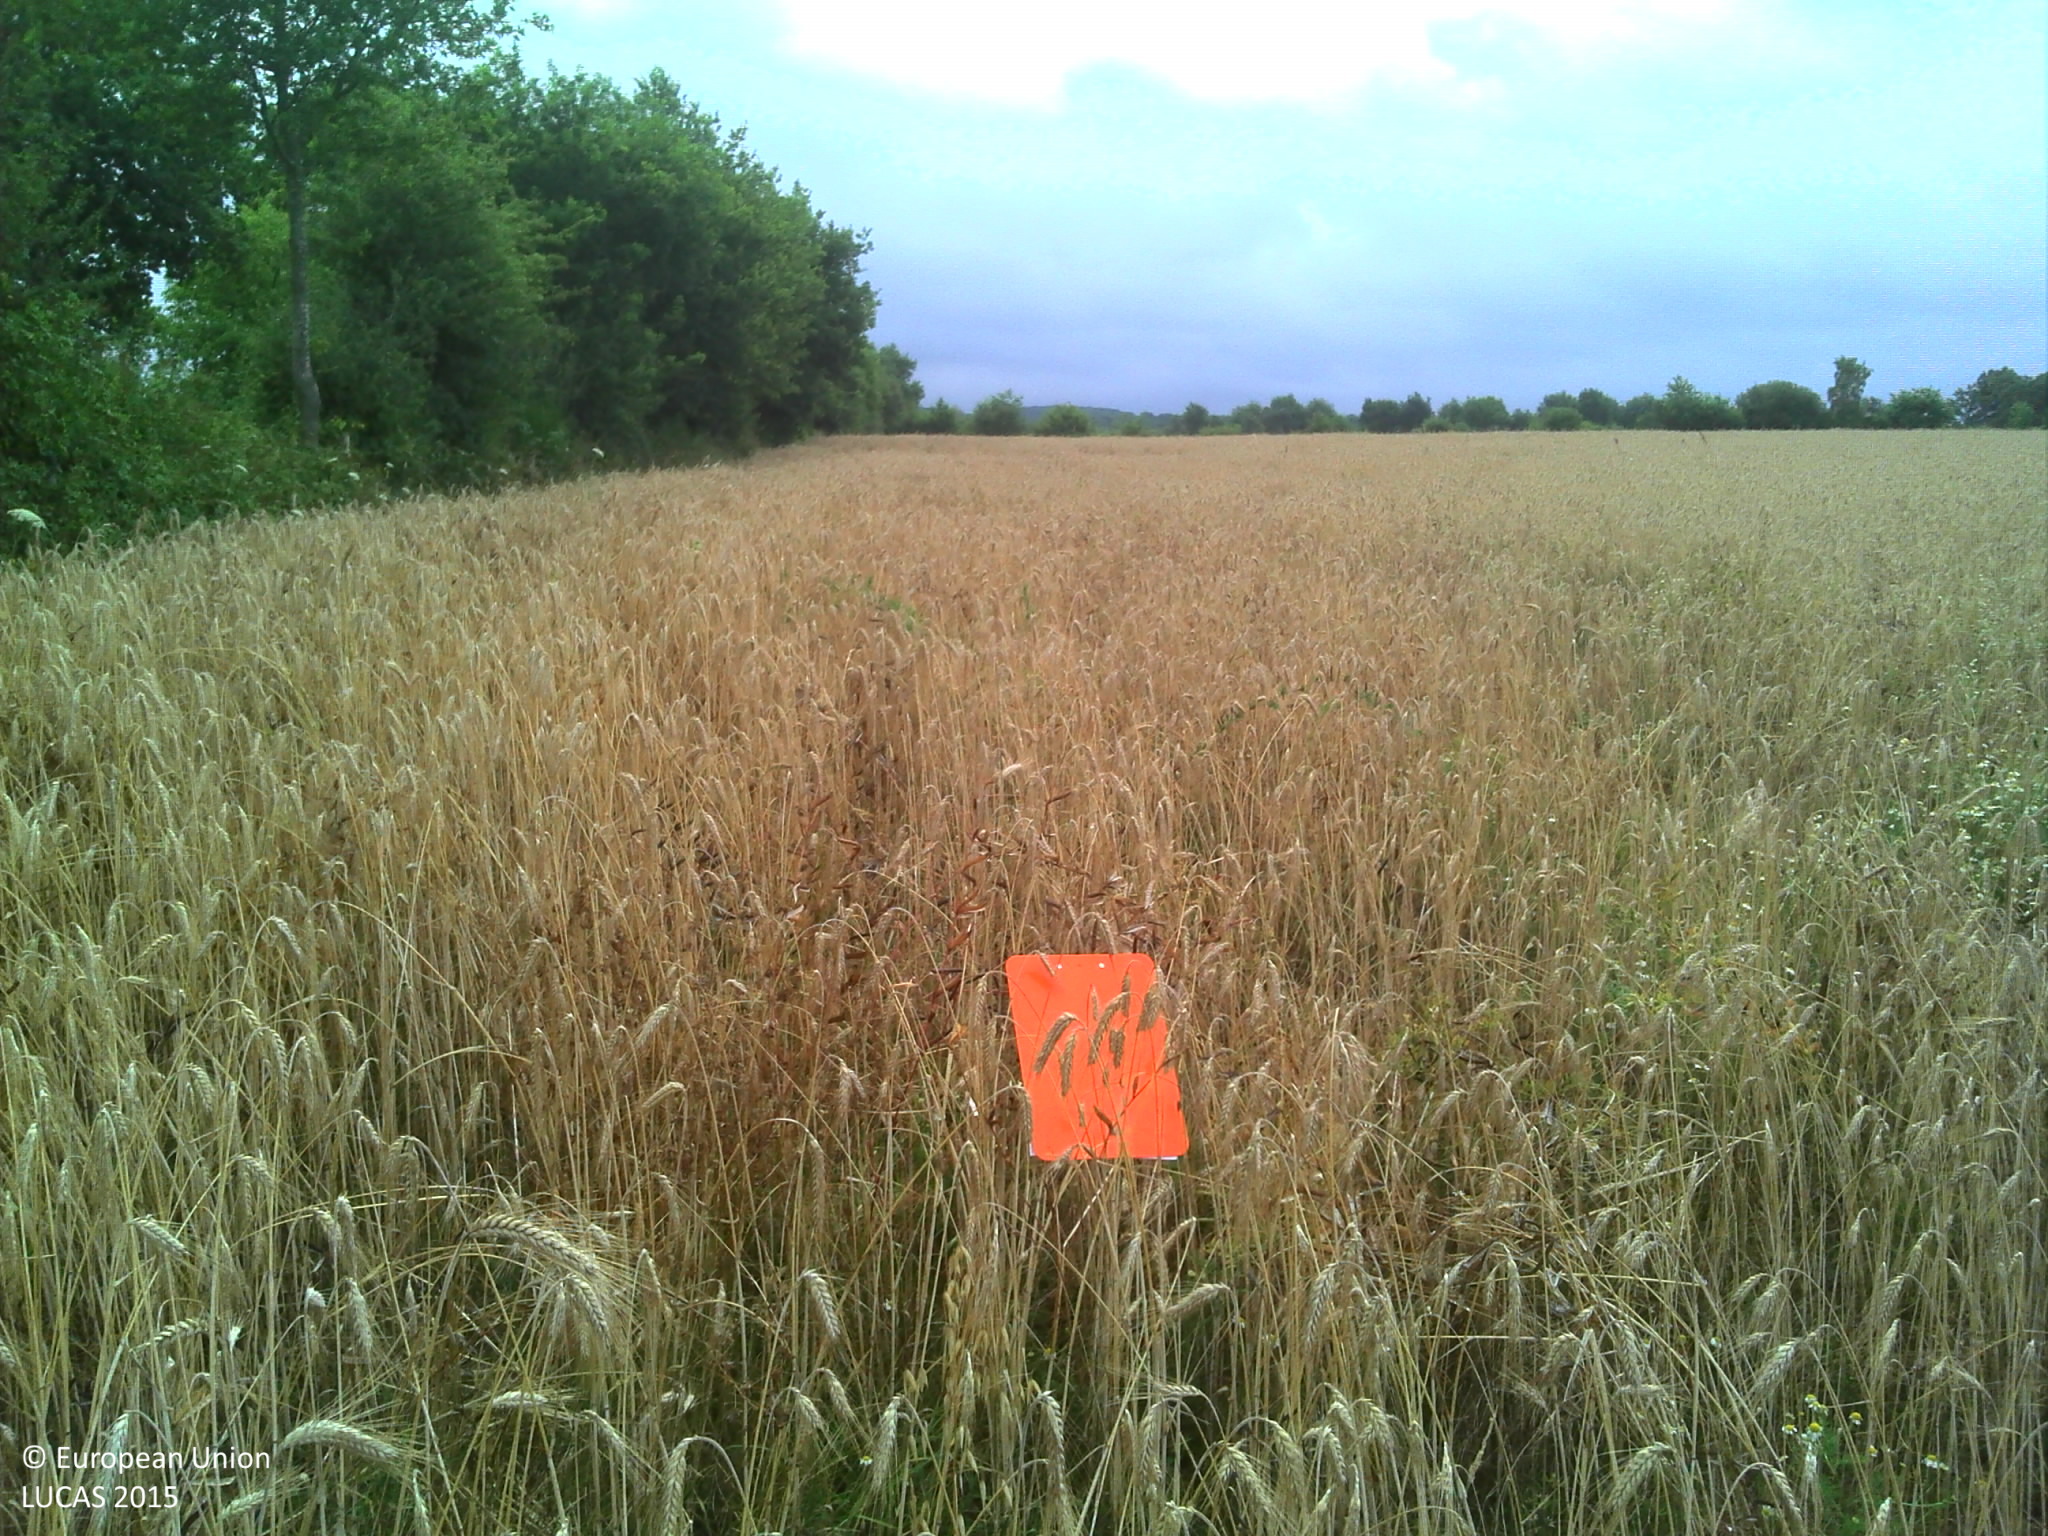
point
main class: Cropland
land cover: Common wheat
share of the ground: > 75 %
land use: Agriculture (excluding fallow land and kitchen gardens)
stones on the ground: 10 - 25 %
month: July
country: FR
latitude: 47.5032
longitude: -1.9037
